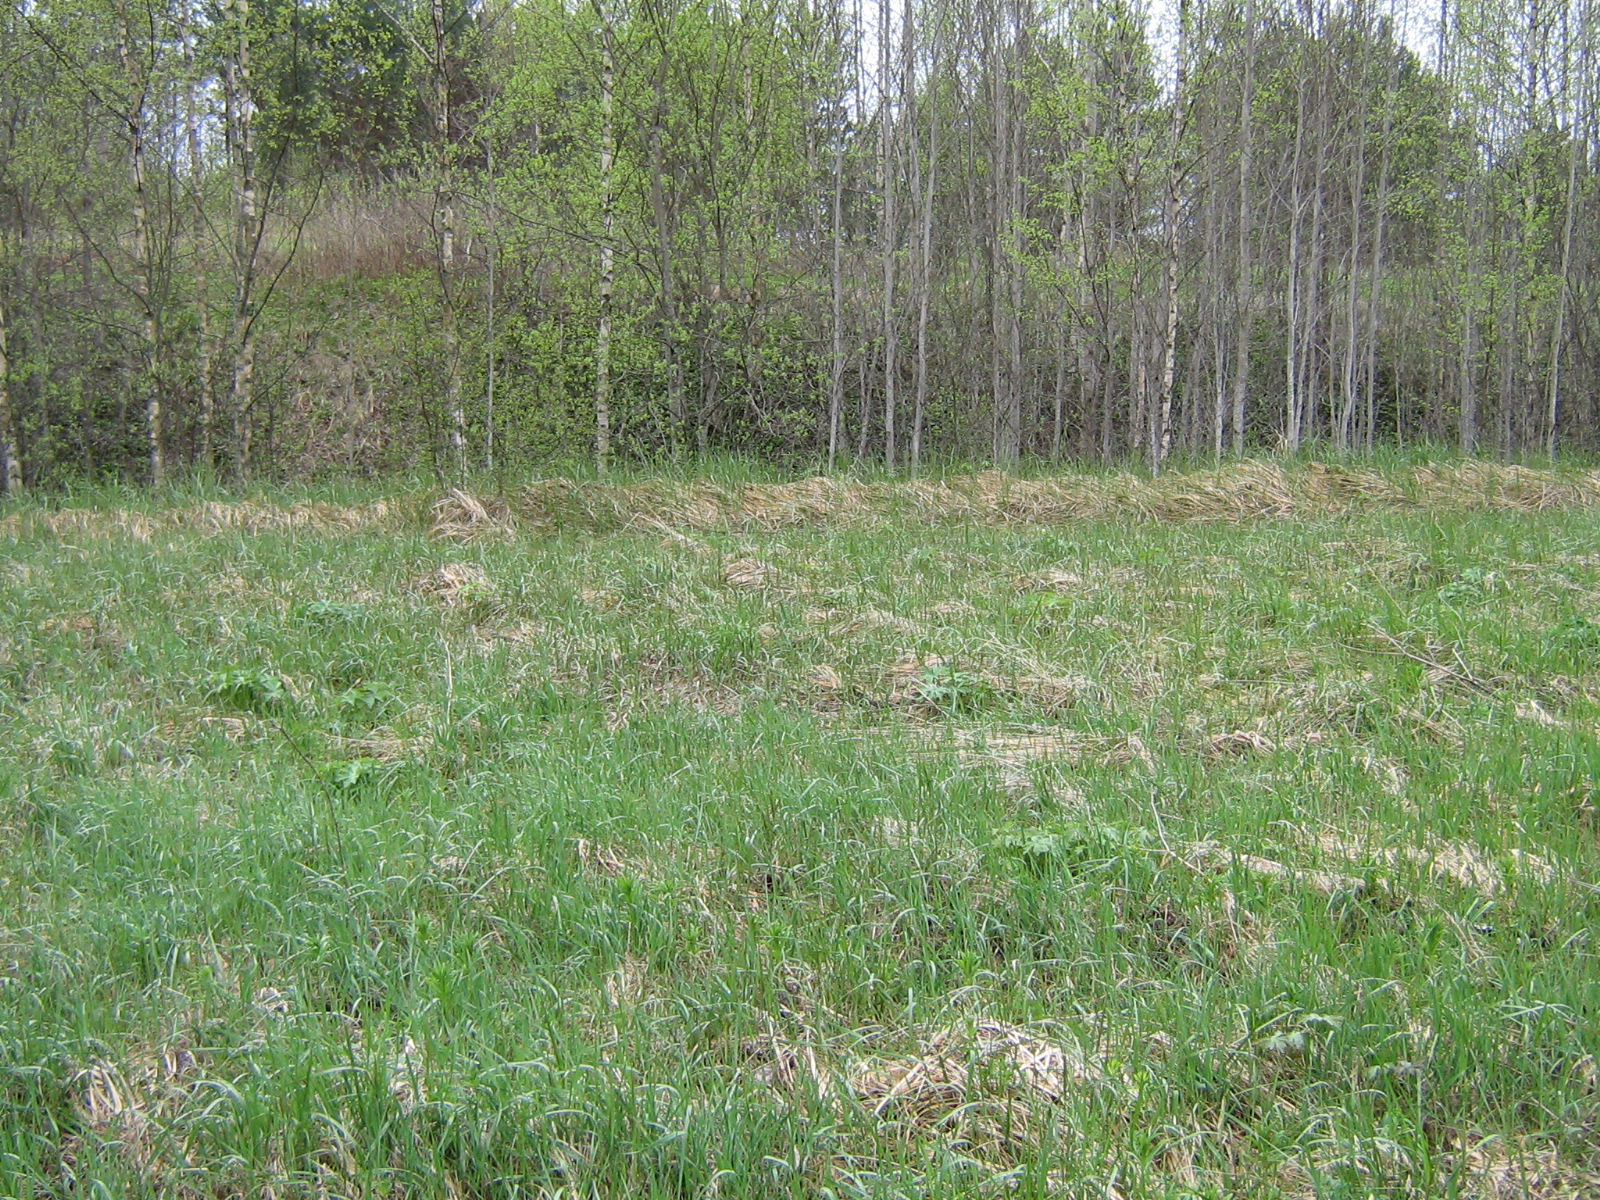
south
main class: Grassland
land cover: Grassland without tree/shrub cover
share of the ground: > 75 %
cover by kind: herbaceous plants 100 %
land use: Semi-natural and natural areas not in use
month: May
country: LV
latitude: 57.2004
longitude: 25.3572
